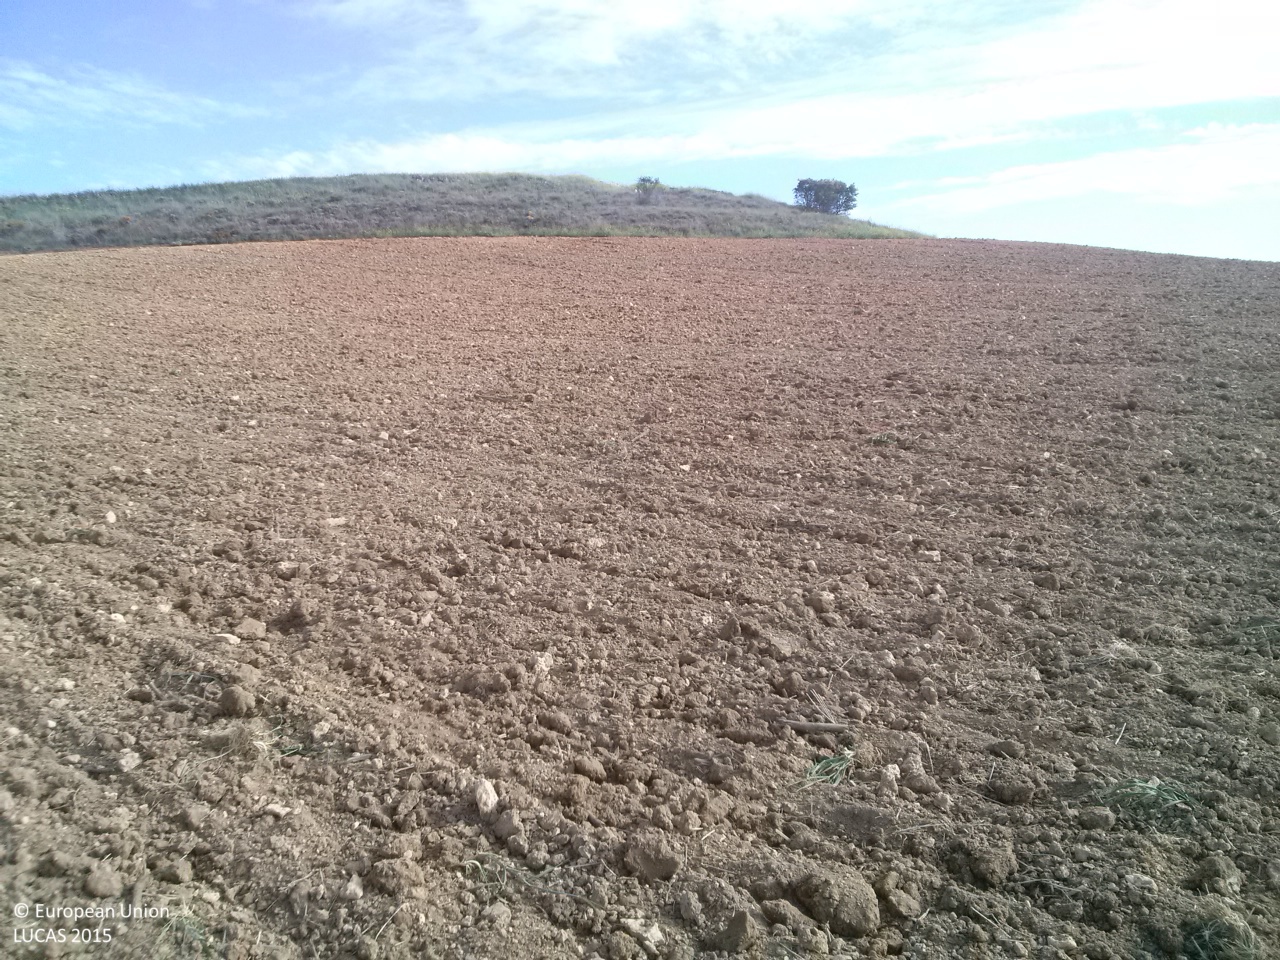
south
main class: Cropland
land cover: Sunflower
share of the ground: < 10 %
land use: Agriculture (excluding fallow land and kitchen gardens)
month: May
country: ES
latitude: 39.8915
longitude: -2.7316
